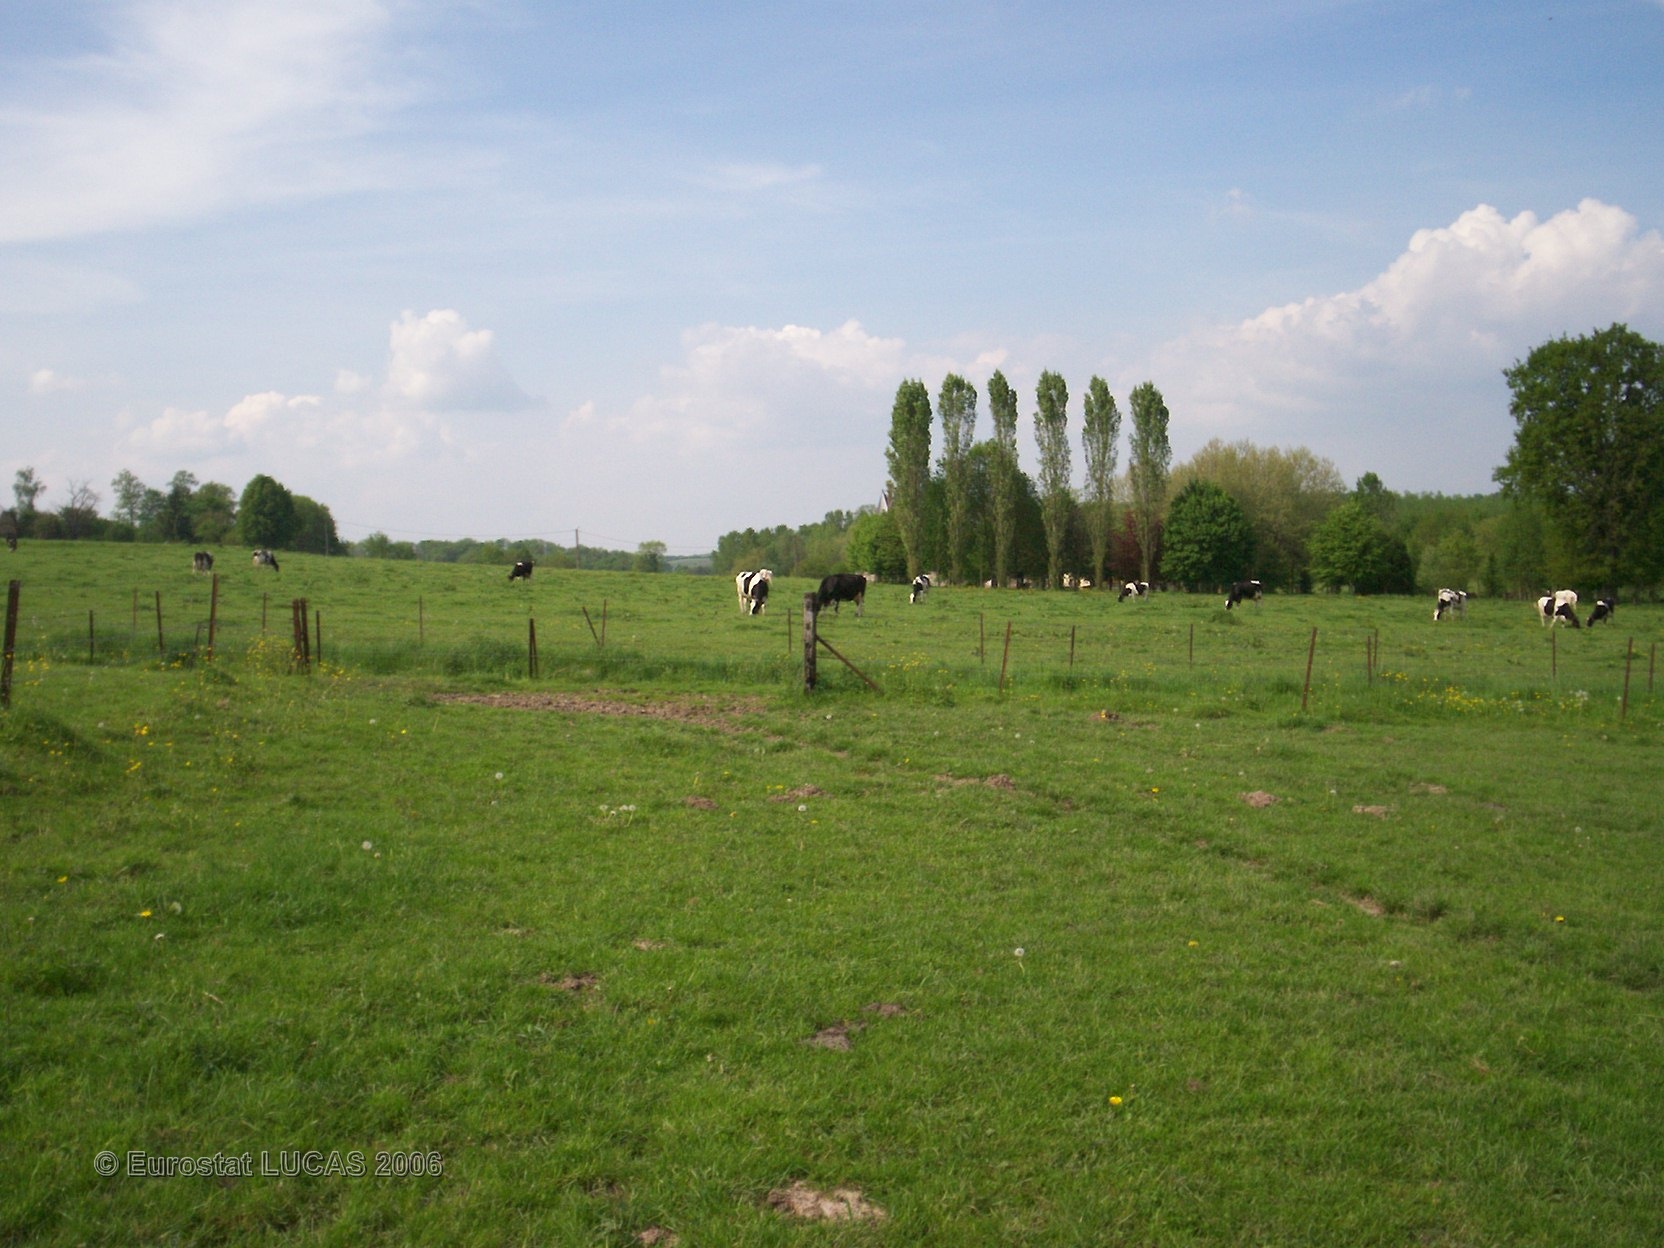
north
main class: Grassland
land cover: Grassland without tree/shrub cover
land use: Agriculture (excluding fallow land and kitchen gardens)
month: May
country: FR
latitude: 49.6273
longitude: 4.3057
